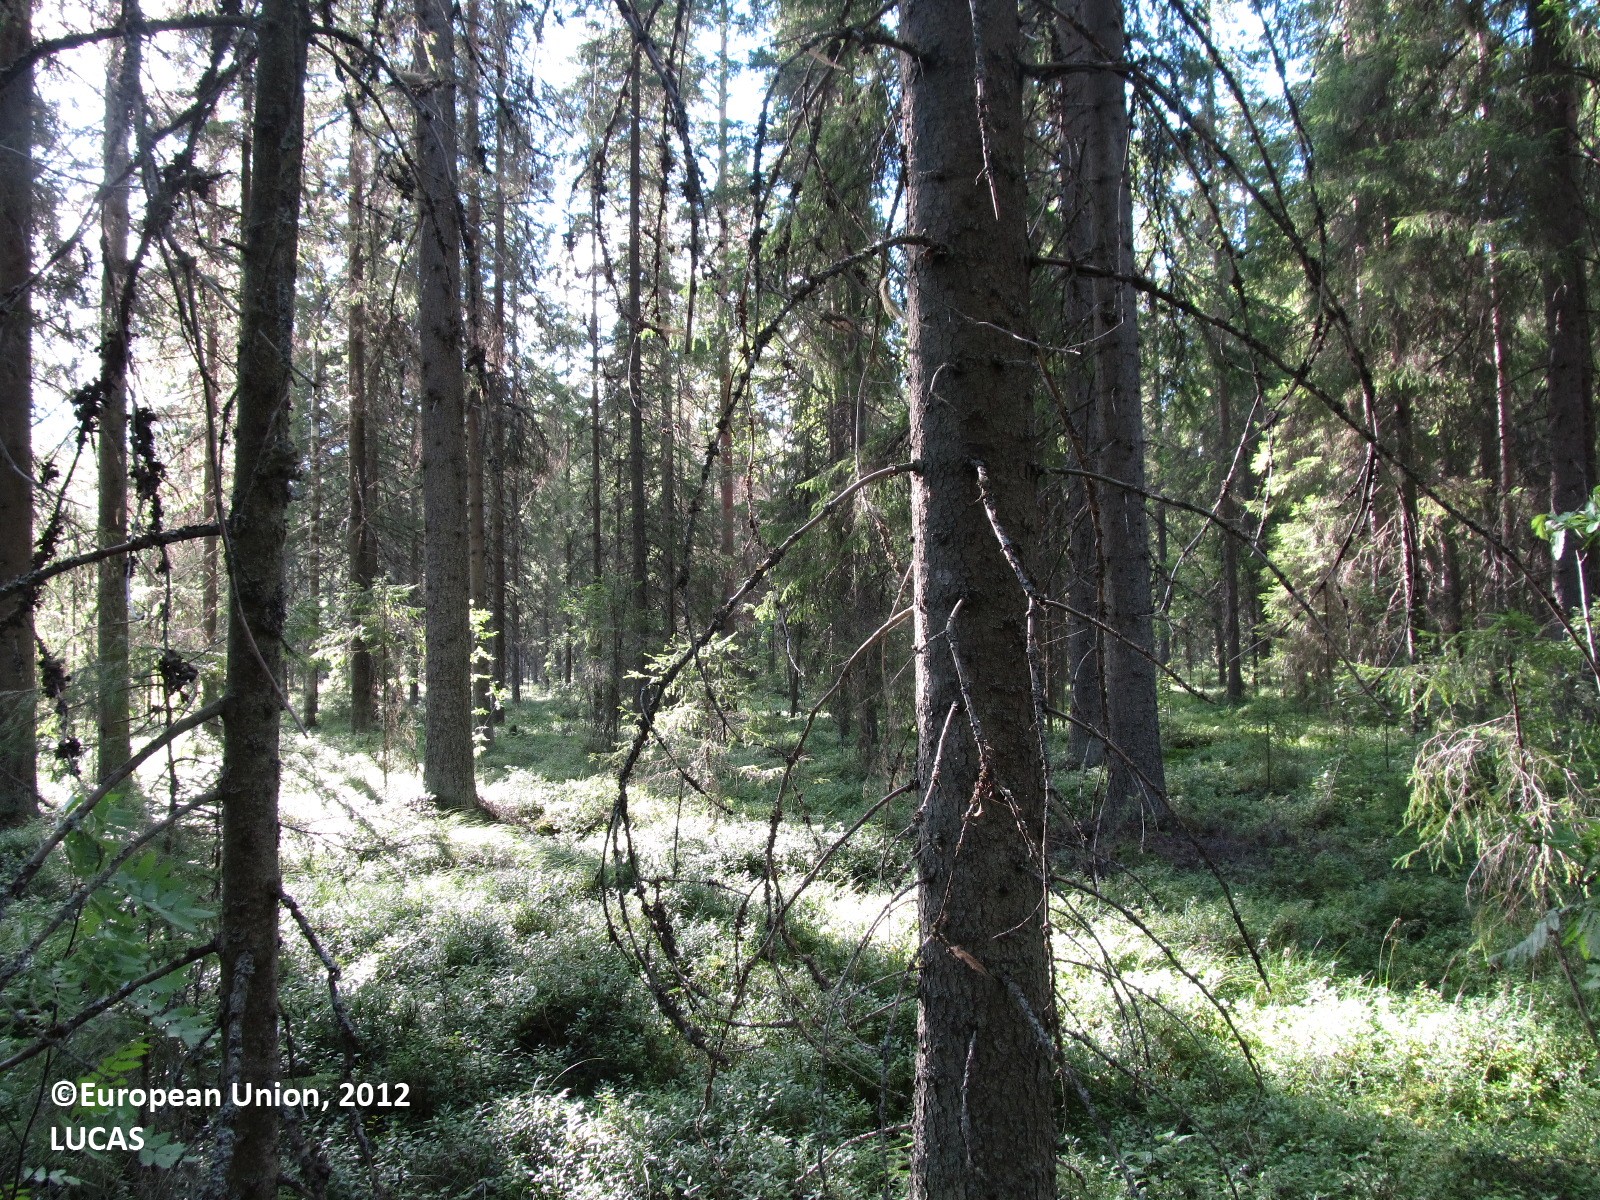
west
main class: Woodland
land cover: Spruce dominated coniferous woodland
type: boreal forest
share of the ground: 25 - 50 %
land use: Forestry
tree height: > 5 m
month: August
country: FI
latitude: 61.8661
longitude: 27.8460
